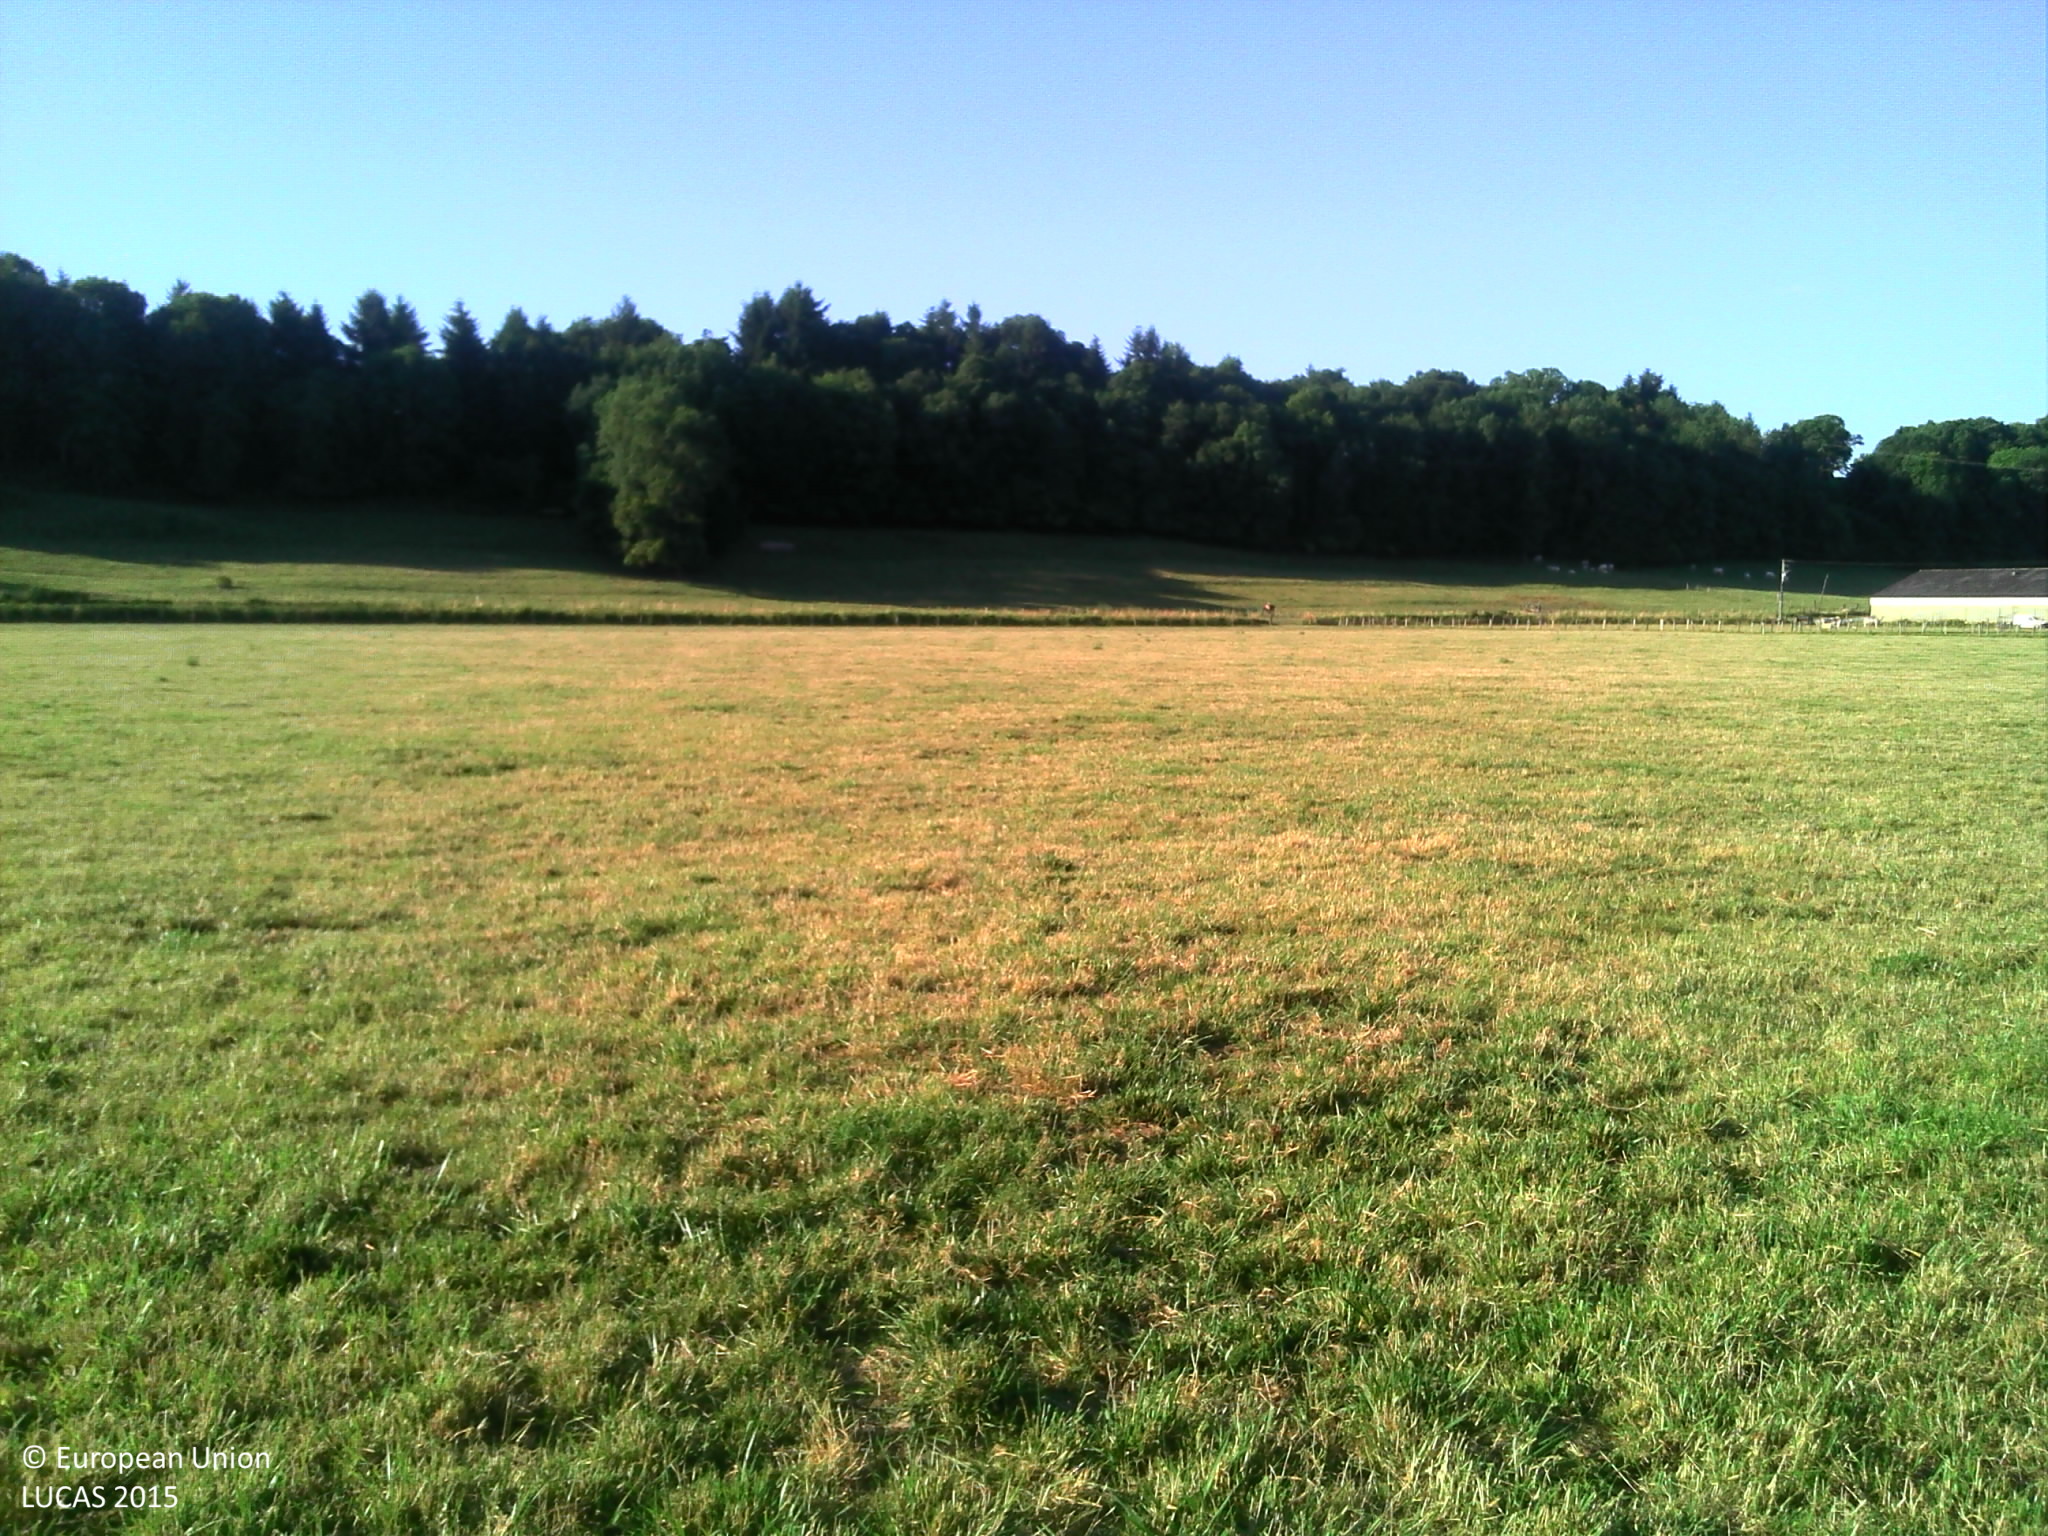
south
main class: Grassland
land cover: Grassland without tree/shrub cover
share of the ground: > 75 %
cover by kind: herbaceous plants 100 %
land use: Agriculture (excluding fallow land and kitchen gardens)
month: July
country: FR
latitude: 48.8837
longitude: 4.9658
